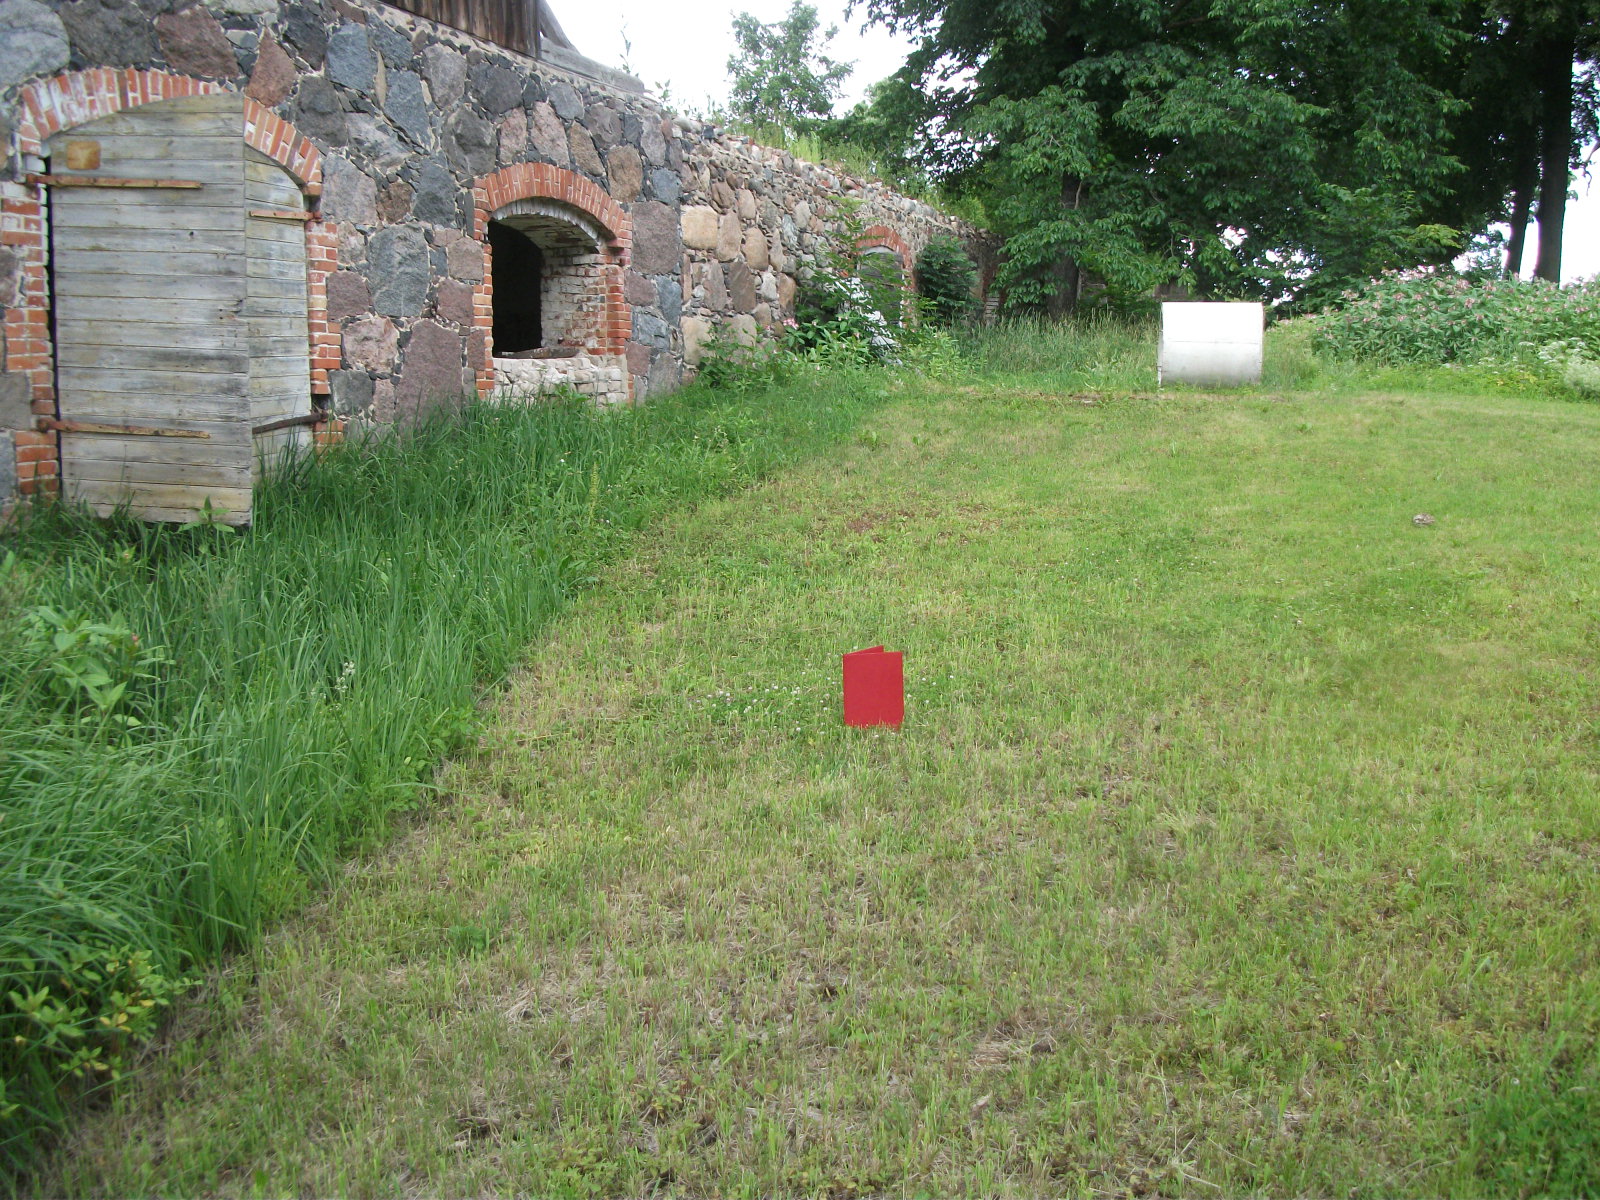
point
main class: Grassland
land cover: Grassland without tree/shrub cover
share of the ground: > 75 %
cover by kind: herbaceous plants 100 %
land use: Residential
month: July
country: LV
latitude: 57.0121
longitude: 26.2944
